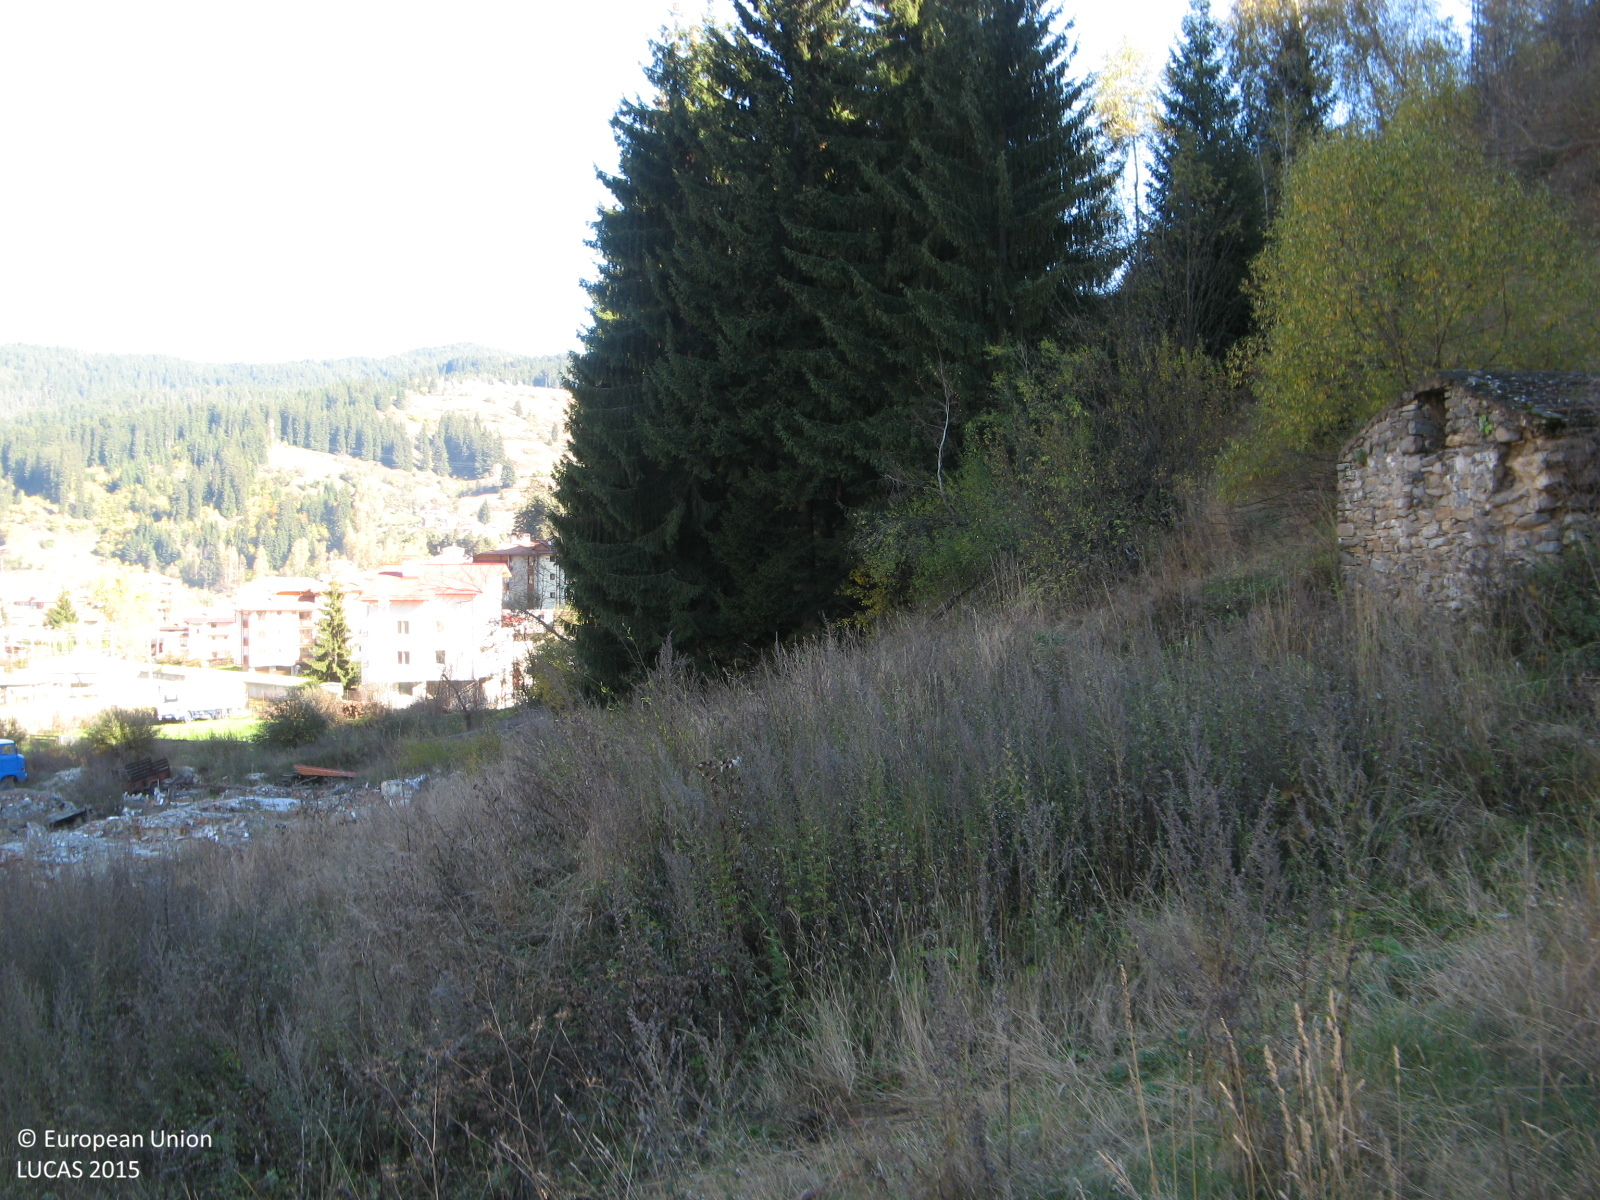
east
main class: Cropland
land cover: Potatoes
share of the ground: < 10 %
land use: Agriculture (excluding fallow land and kitchen gardens)
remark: Harvested field
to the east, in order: Potatoes; Grassland without tree/shrub cover; Artificial constructions in urban areas; Grassland without tree/shrub cover; Abandoned hedges; Fences; Grassland without tree/shrub cover; Artificial constructions in urban areas; Grassland without tree/shrub cover
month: October
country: BG
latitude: 41.7251
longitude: 24.6749
